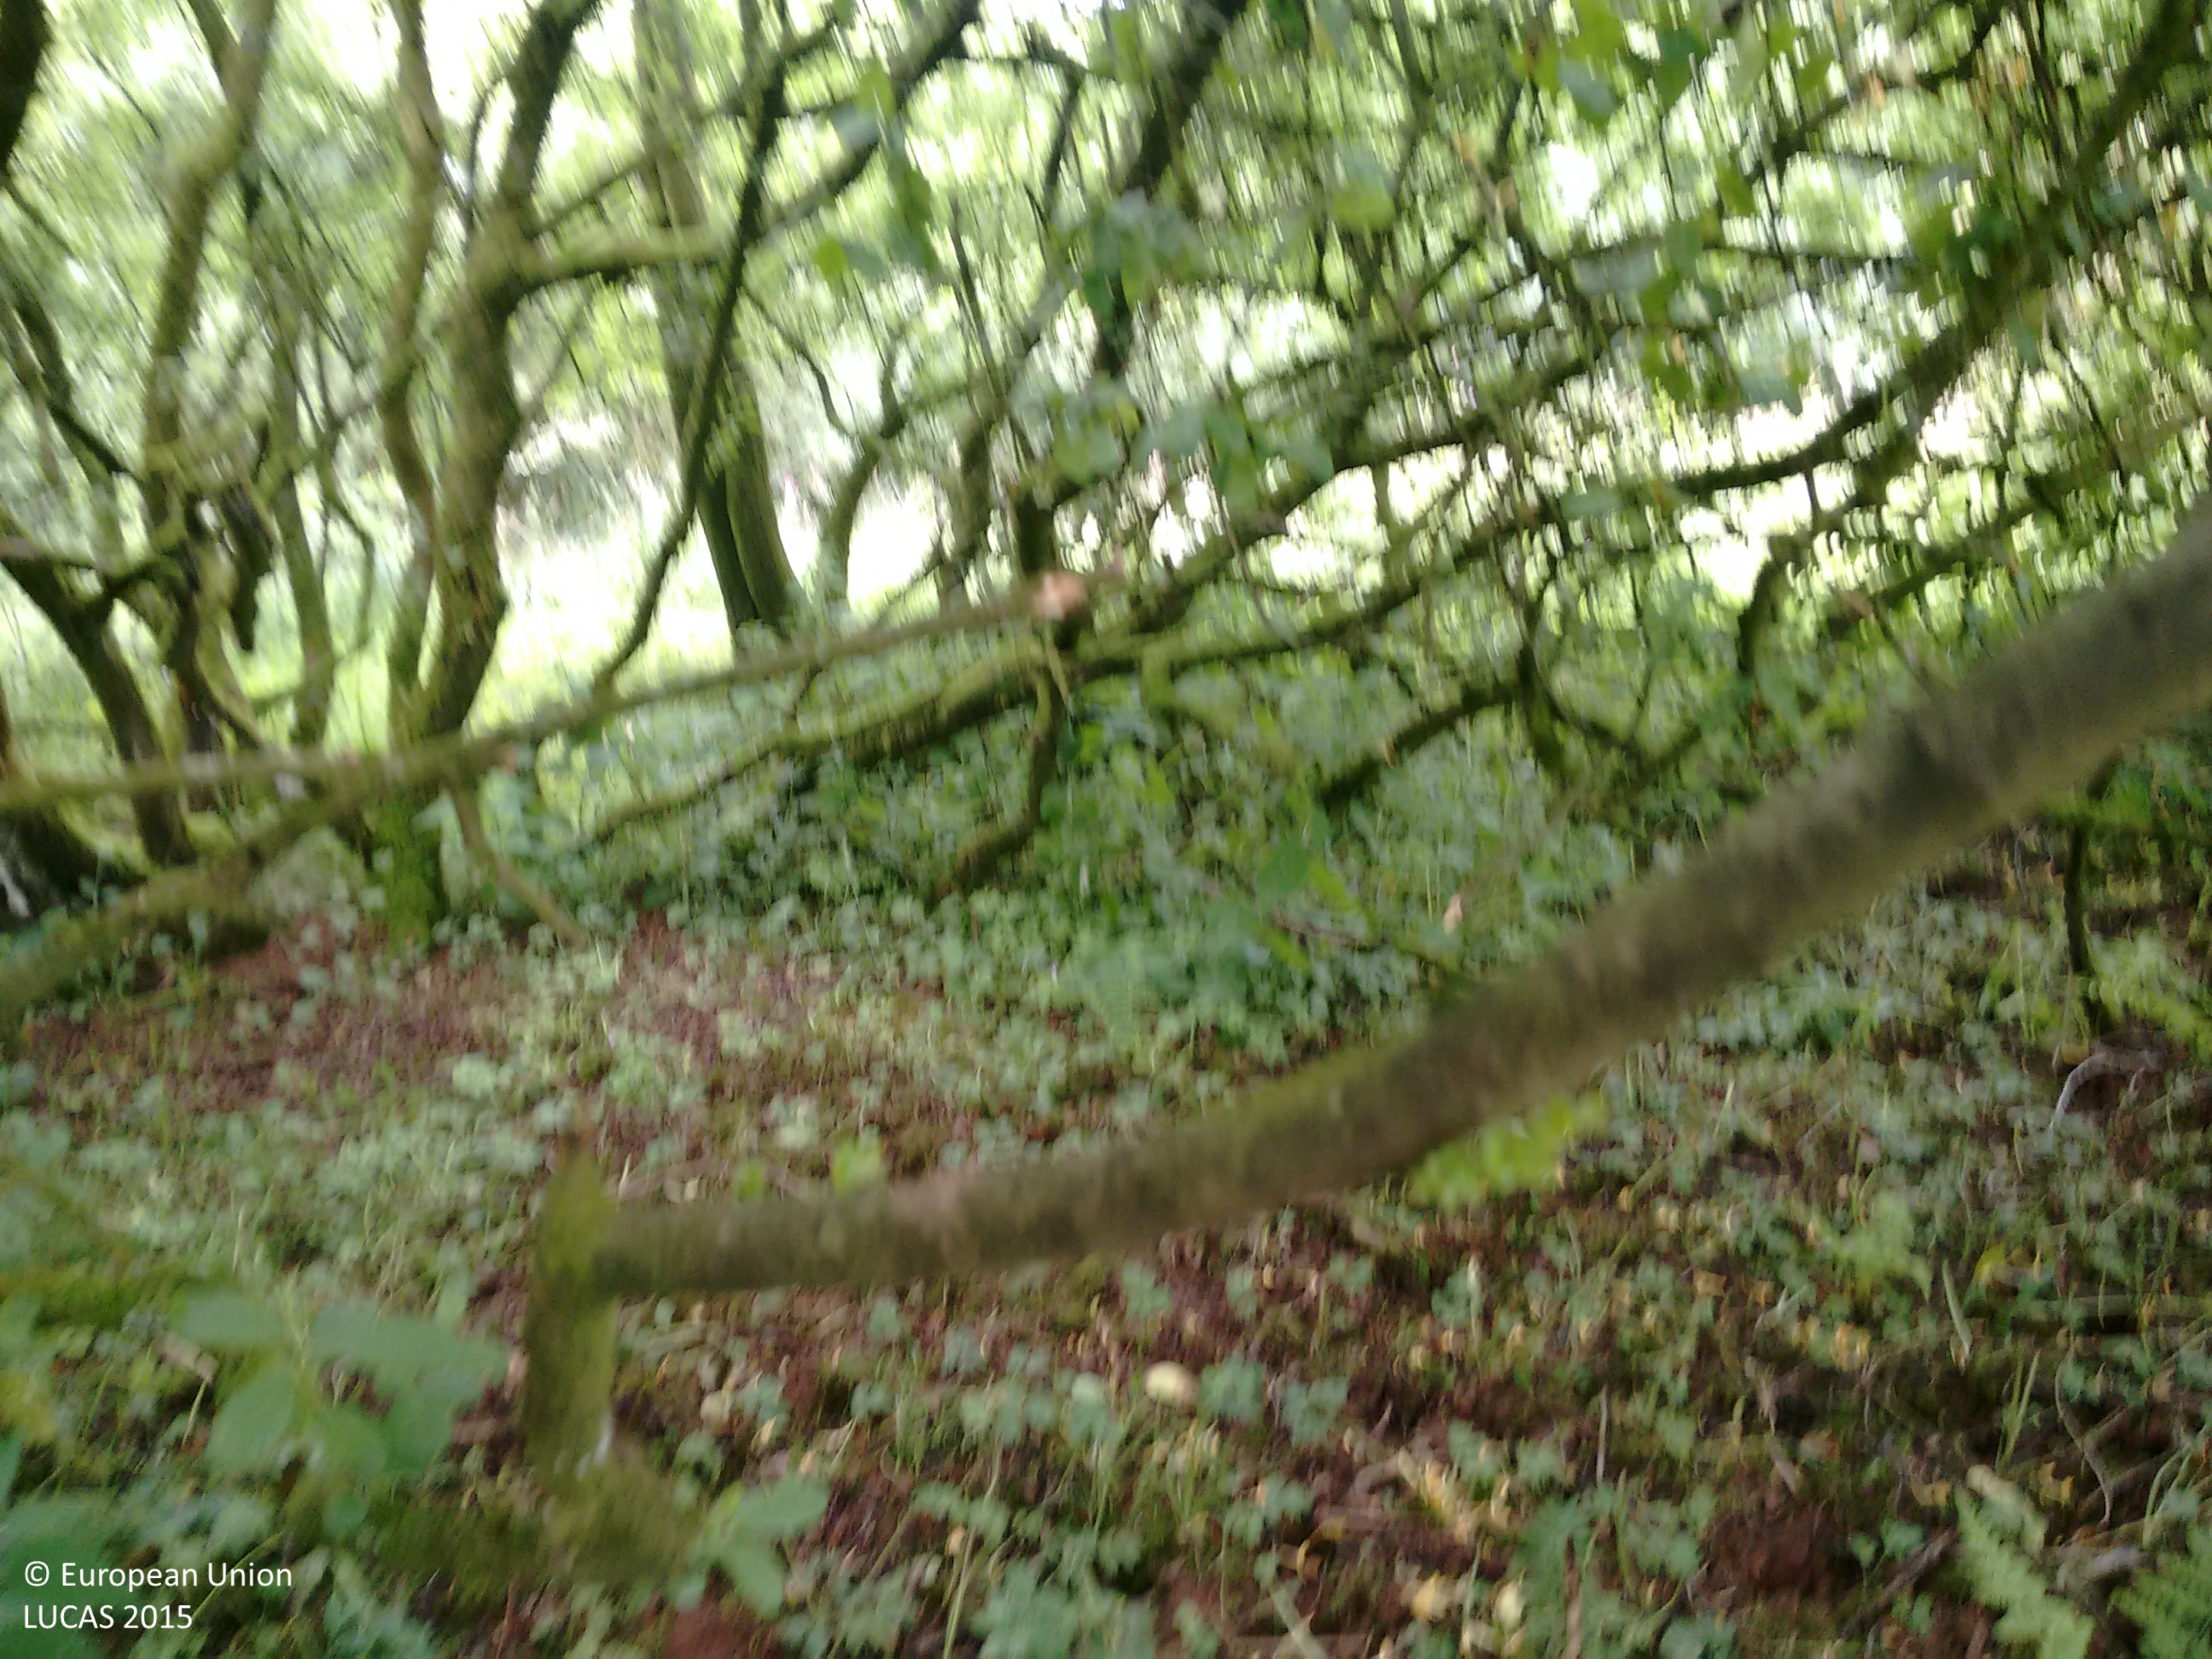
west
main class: Grassland
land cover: Grassland without tree/shrub cover
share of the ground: < 10 %
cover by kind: herbaceous plants 100 %
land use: Agriculture (excluding fallow land and kitchen gardens)
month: July
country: GB
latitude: 55.5372
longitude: -4.3740
